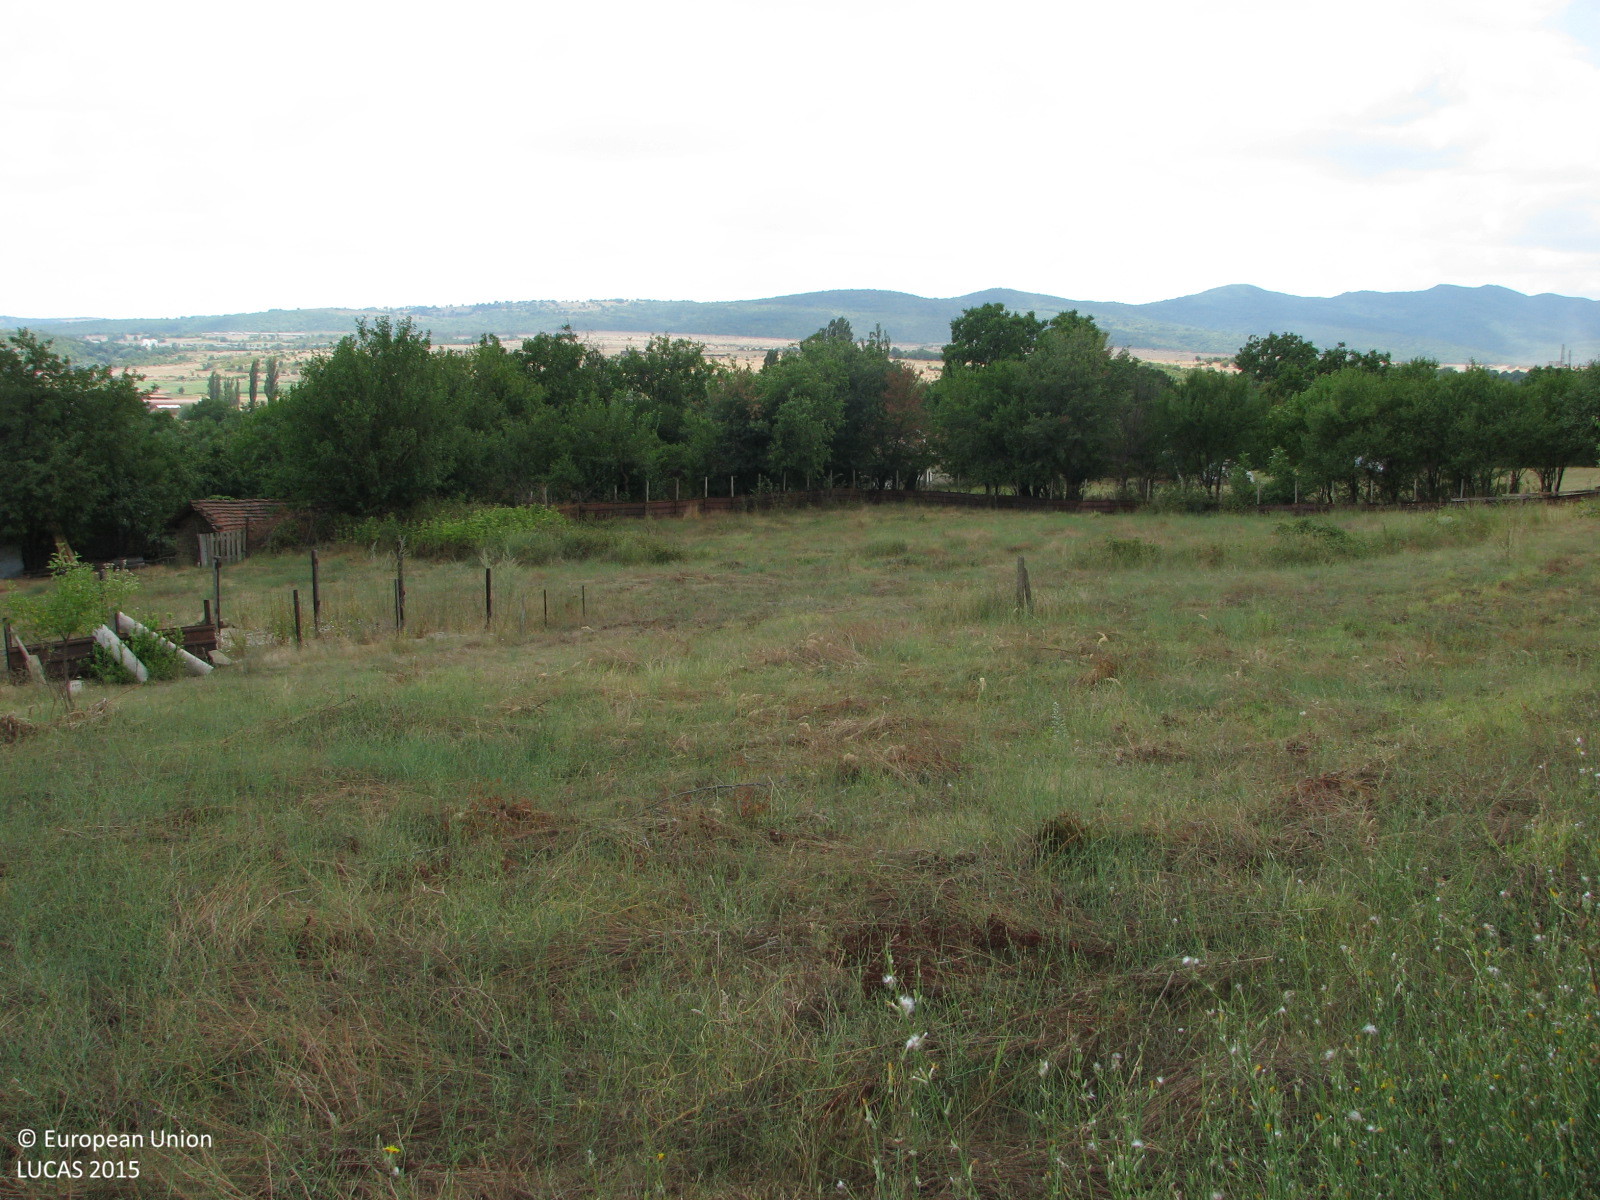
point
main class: Grassland
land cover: Grassland without tree/shrub cover
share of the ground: > 75 %
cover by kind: herbaceous plants 100 %
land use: Agriculture (excluding fallow land and kitchen gardens)
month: August
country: BG
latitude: 42.7404
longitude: 26.6259
